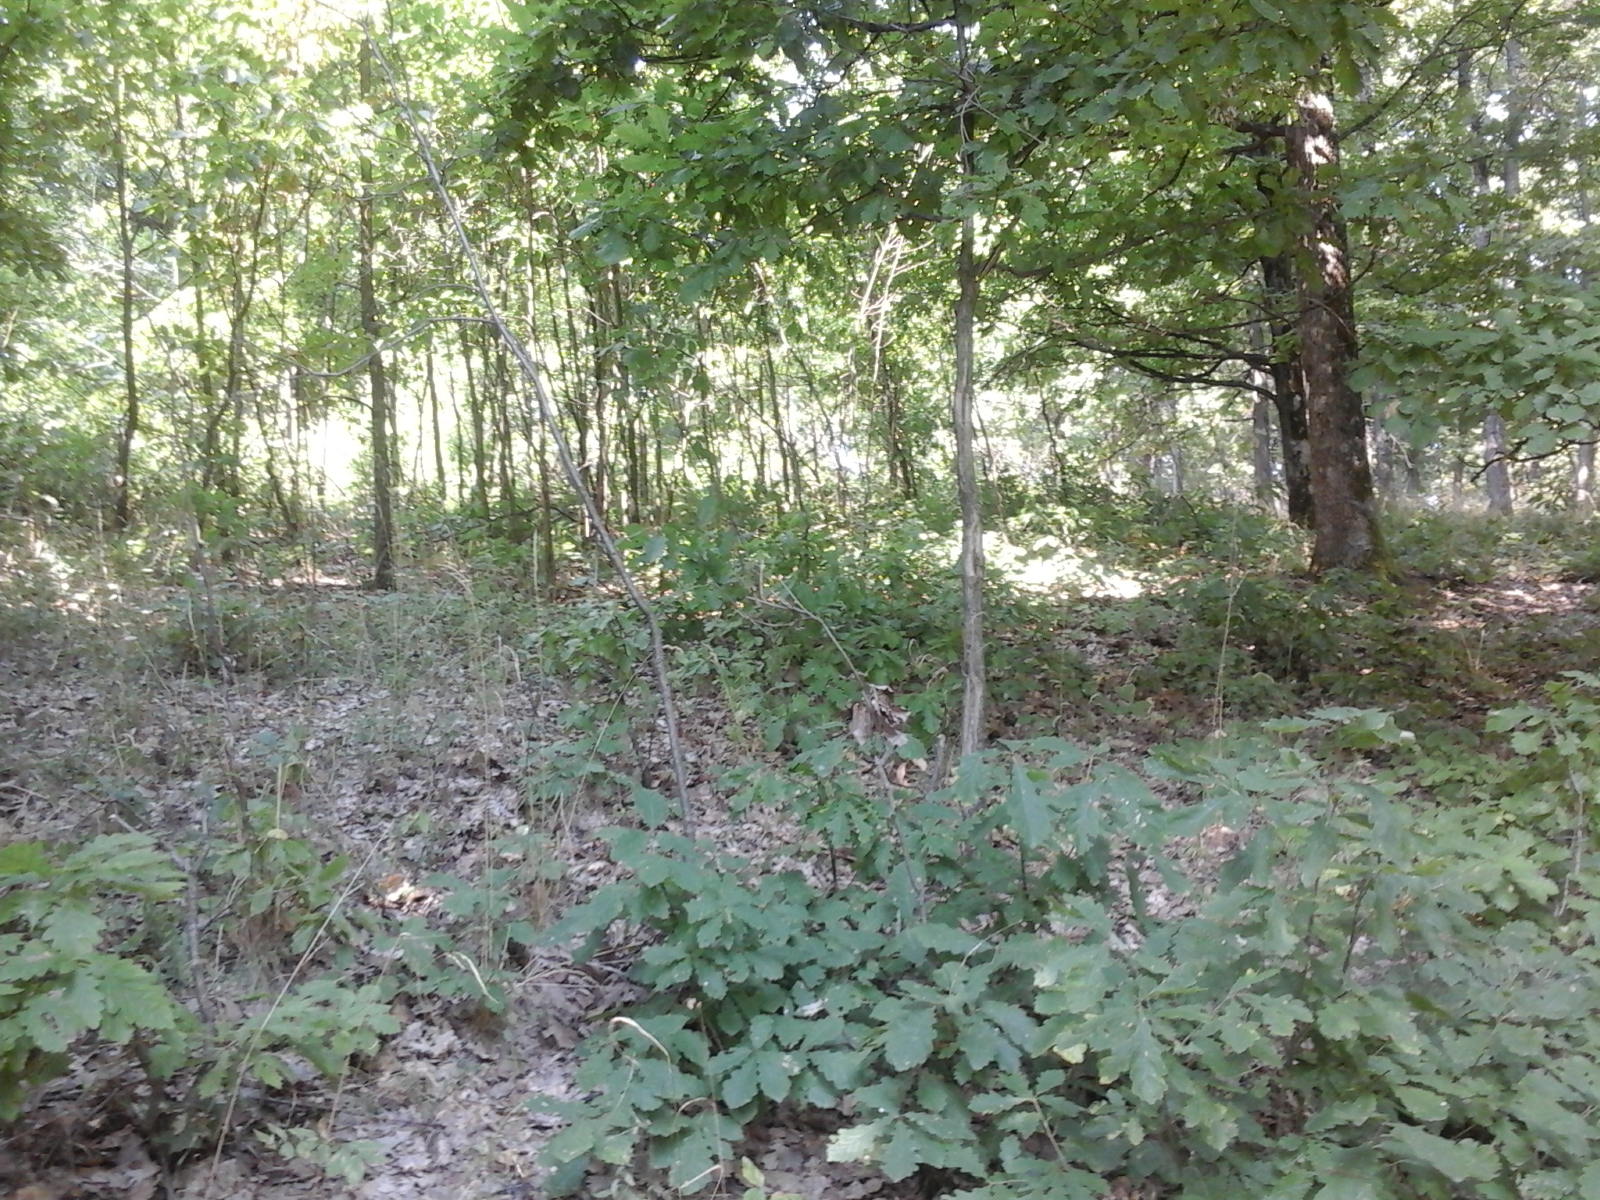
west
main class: Woodland
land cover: Broadleaved woodland
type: acidophilous oak and oak-birch forest
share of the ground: > 75 %
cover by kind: broadleaved forest trees 100 %
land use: Forestry
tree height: > 5 m
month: August
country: RO
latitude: 44.8302
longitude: 23.9390
